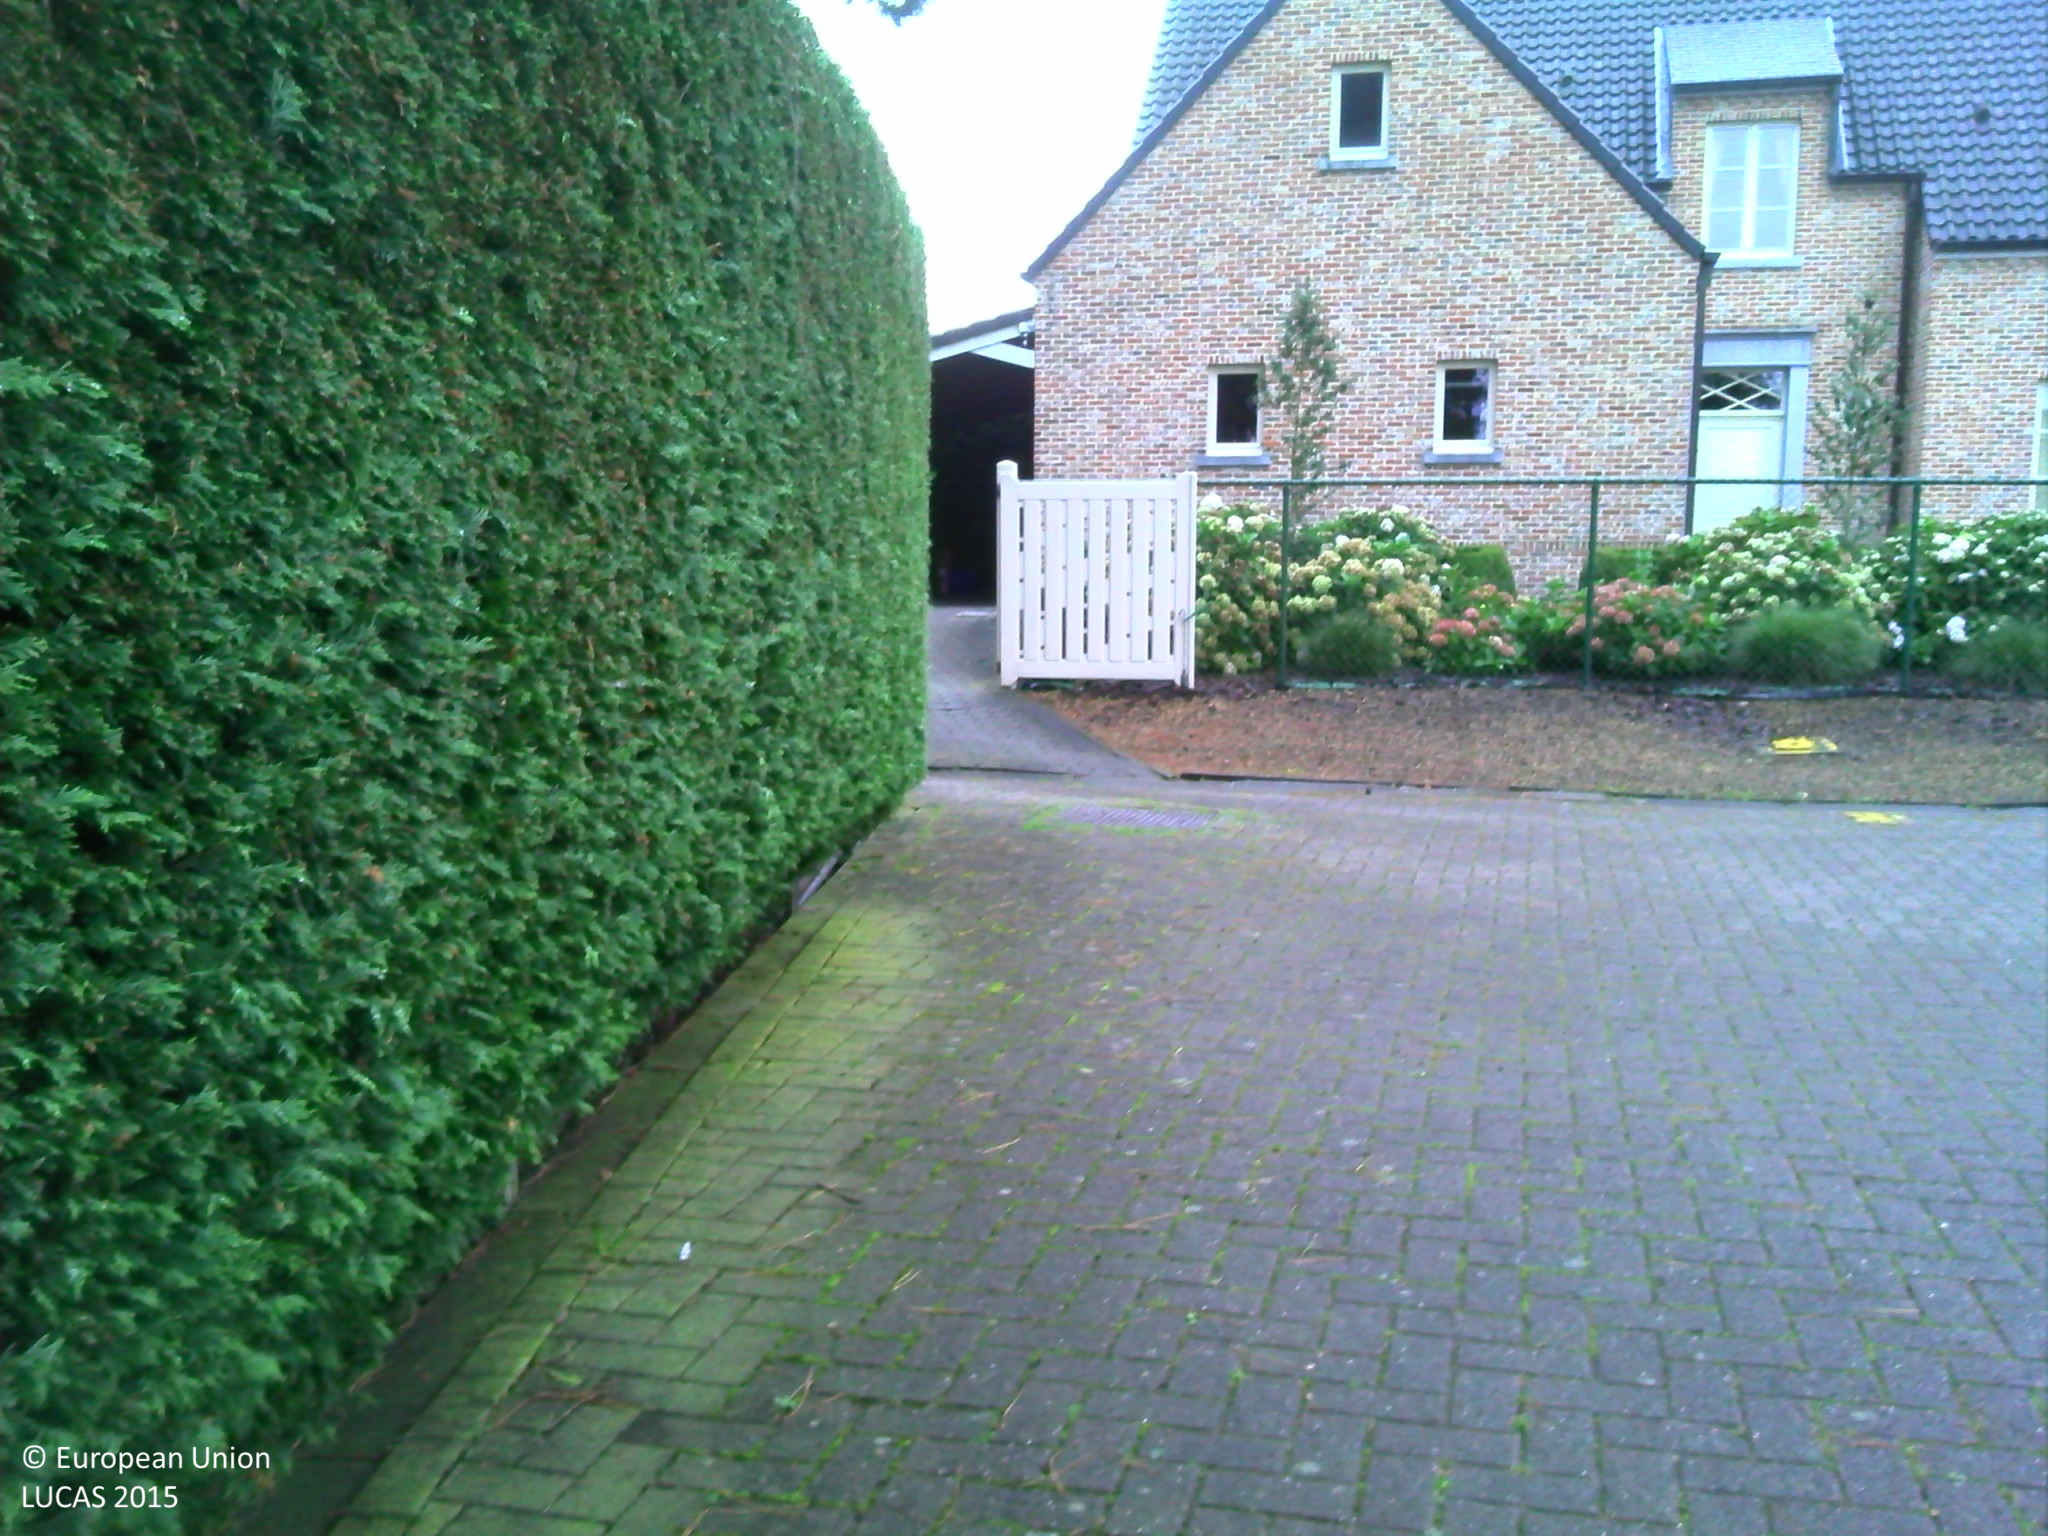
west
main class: Woodland
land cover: Pine dominated coniferous woodland
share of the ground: > 75 %
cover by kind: coniferous forest trees 95 %, herbaceous plants 5 %
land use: Residential
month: October
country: BE
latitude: 51.0741
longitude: 4.7871
